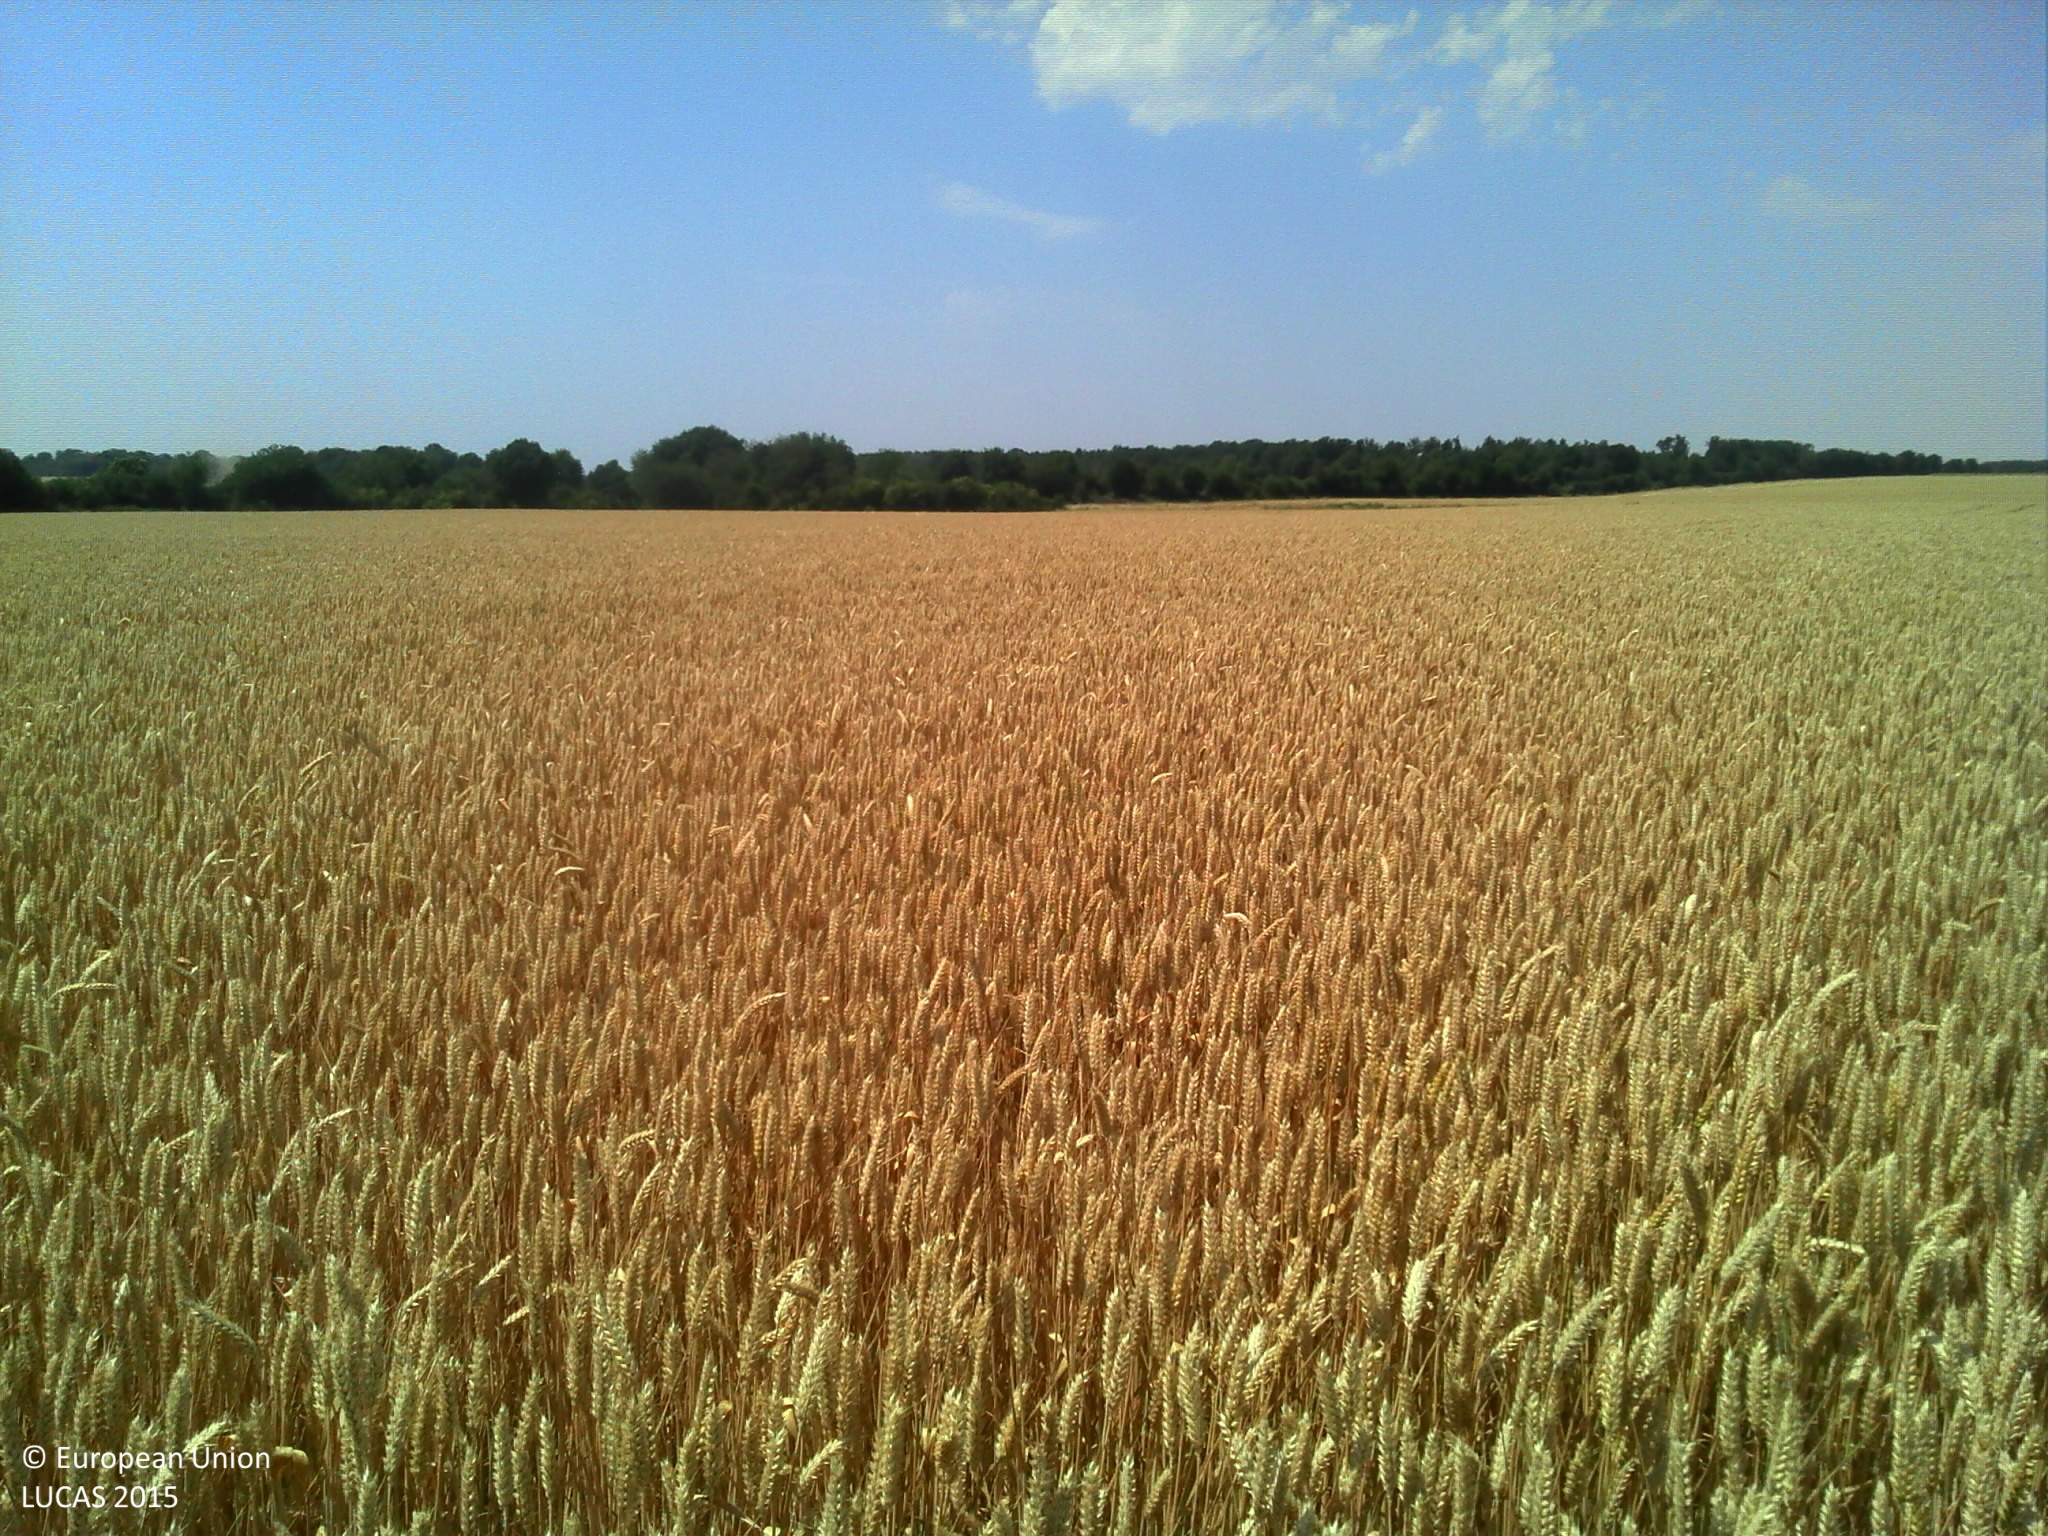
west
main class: Cropland
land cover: Common wheat
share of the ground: > 75 %
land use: Agriculture (excluding fallow land and kitchen gardens)
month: July
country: FR
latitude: 48.9411
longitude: 1.2289
